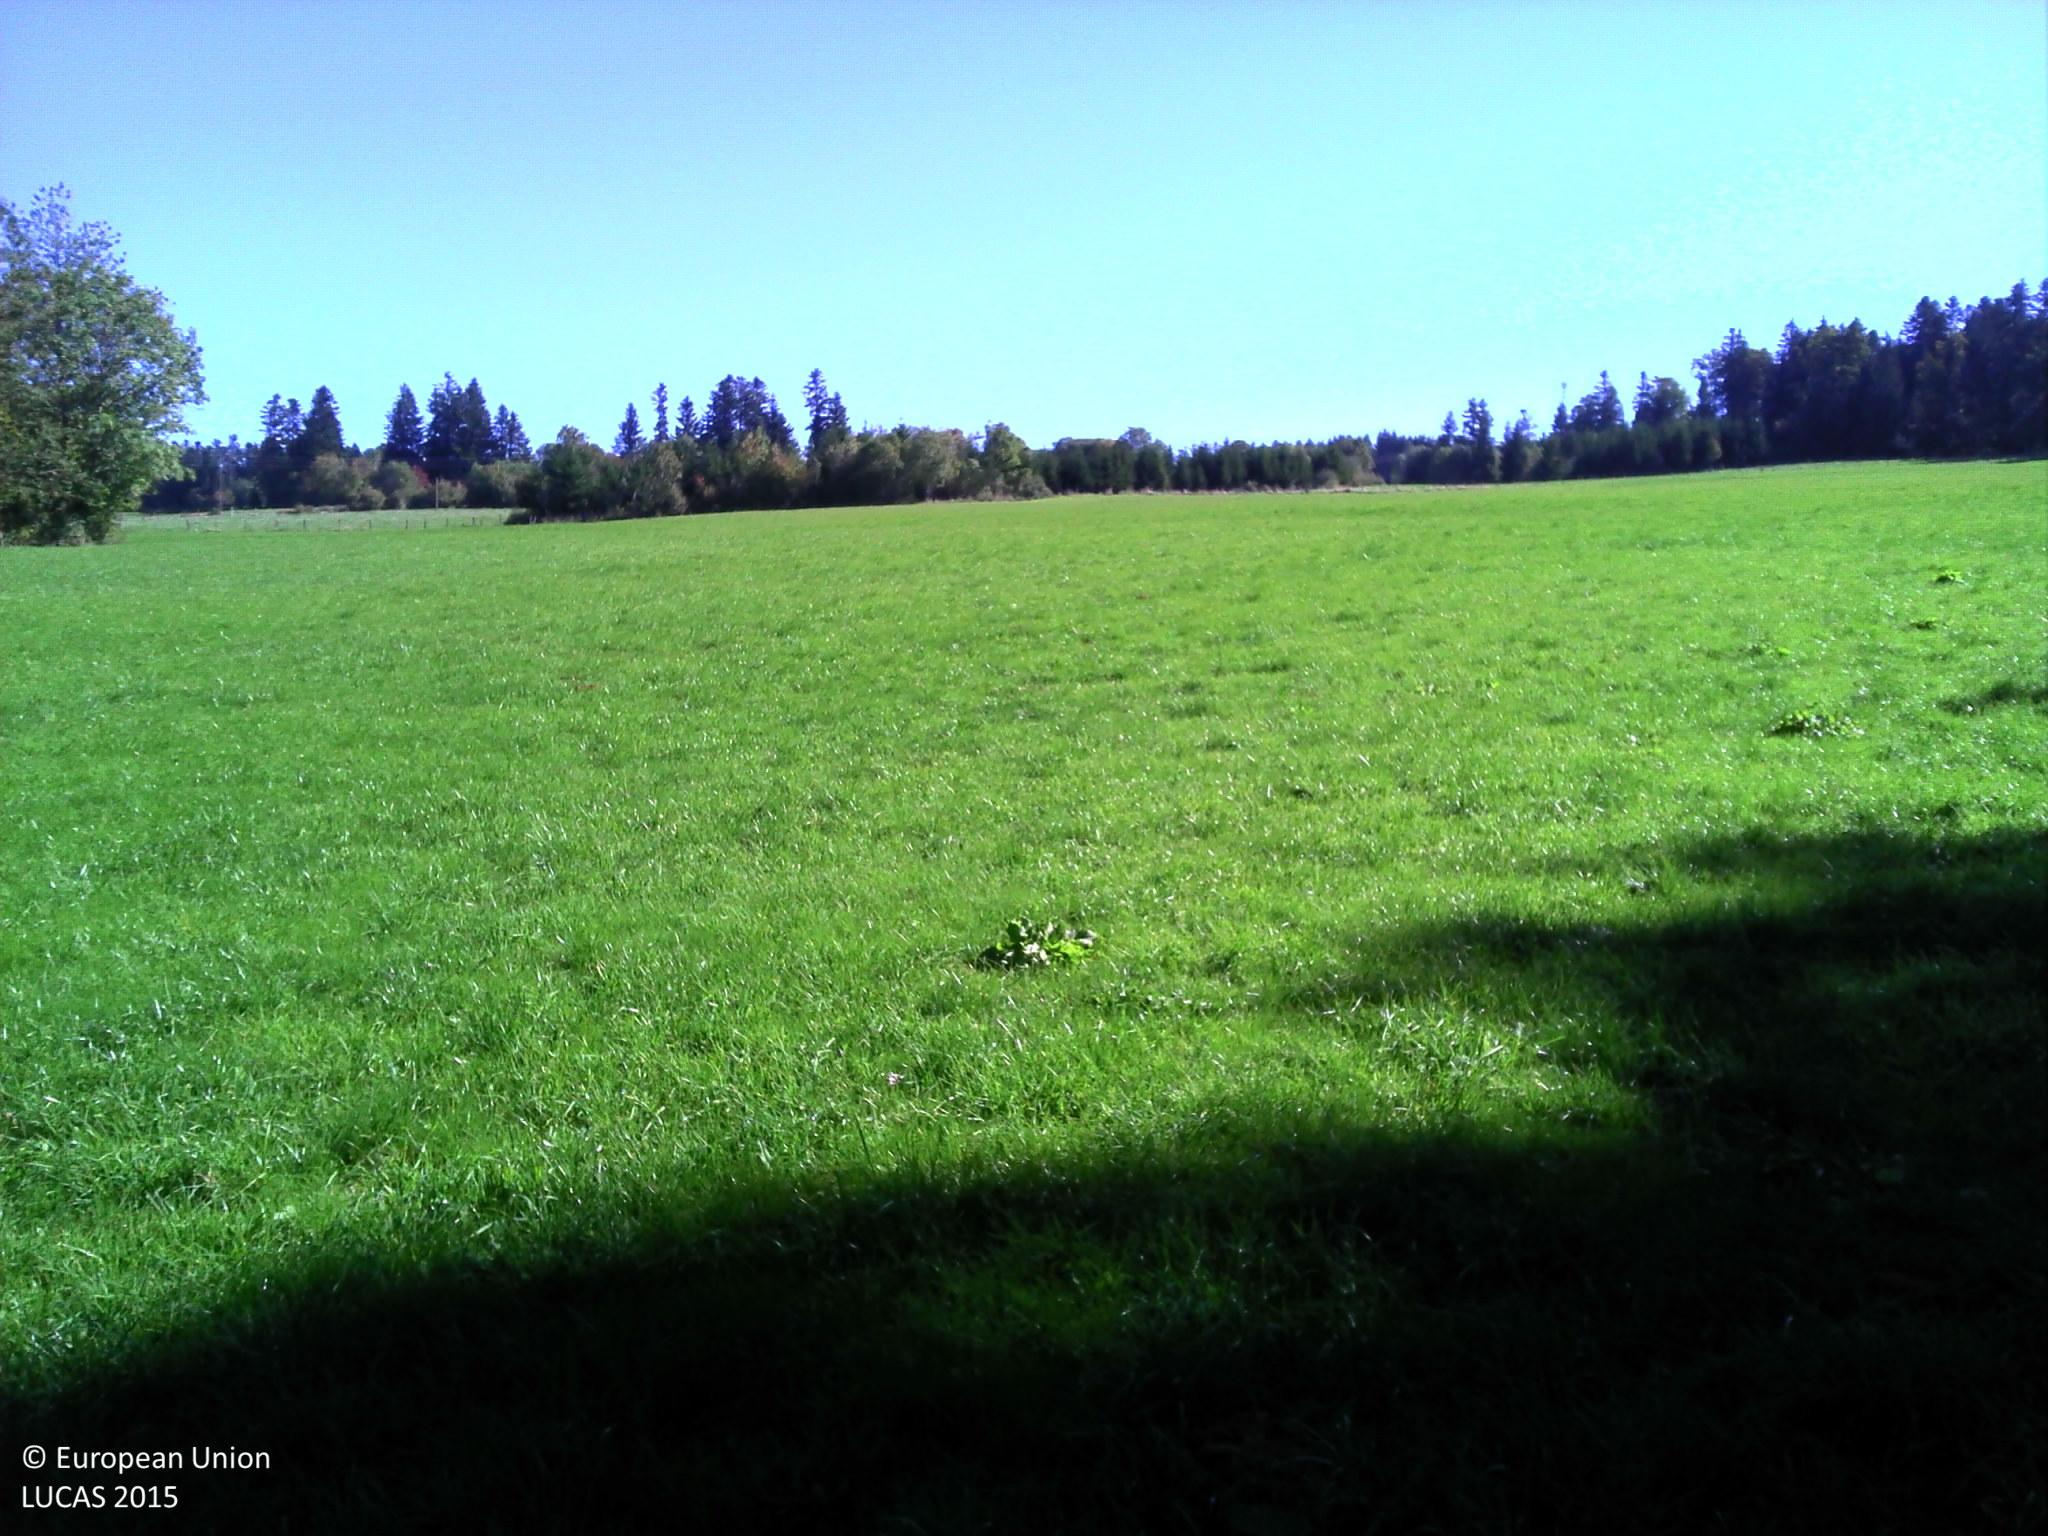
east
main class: Grassland
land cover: Grassland without tree/shrub cover
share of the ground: > 75 %
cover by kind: herbaceous plants 100 %
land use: Agriculture (excluding fallow land and kitchen gardens)
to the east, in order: Grassland without tree/shrub cover; Fences; Grassland without tree/shrub cover; Fences; Spruce dominated mixed woodland
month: September
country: FR
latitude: 47.1455
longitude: 6.6395
